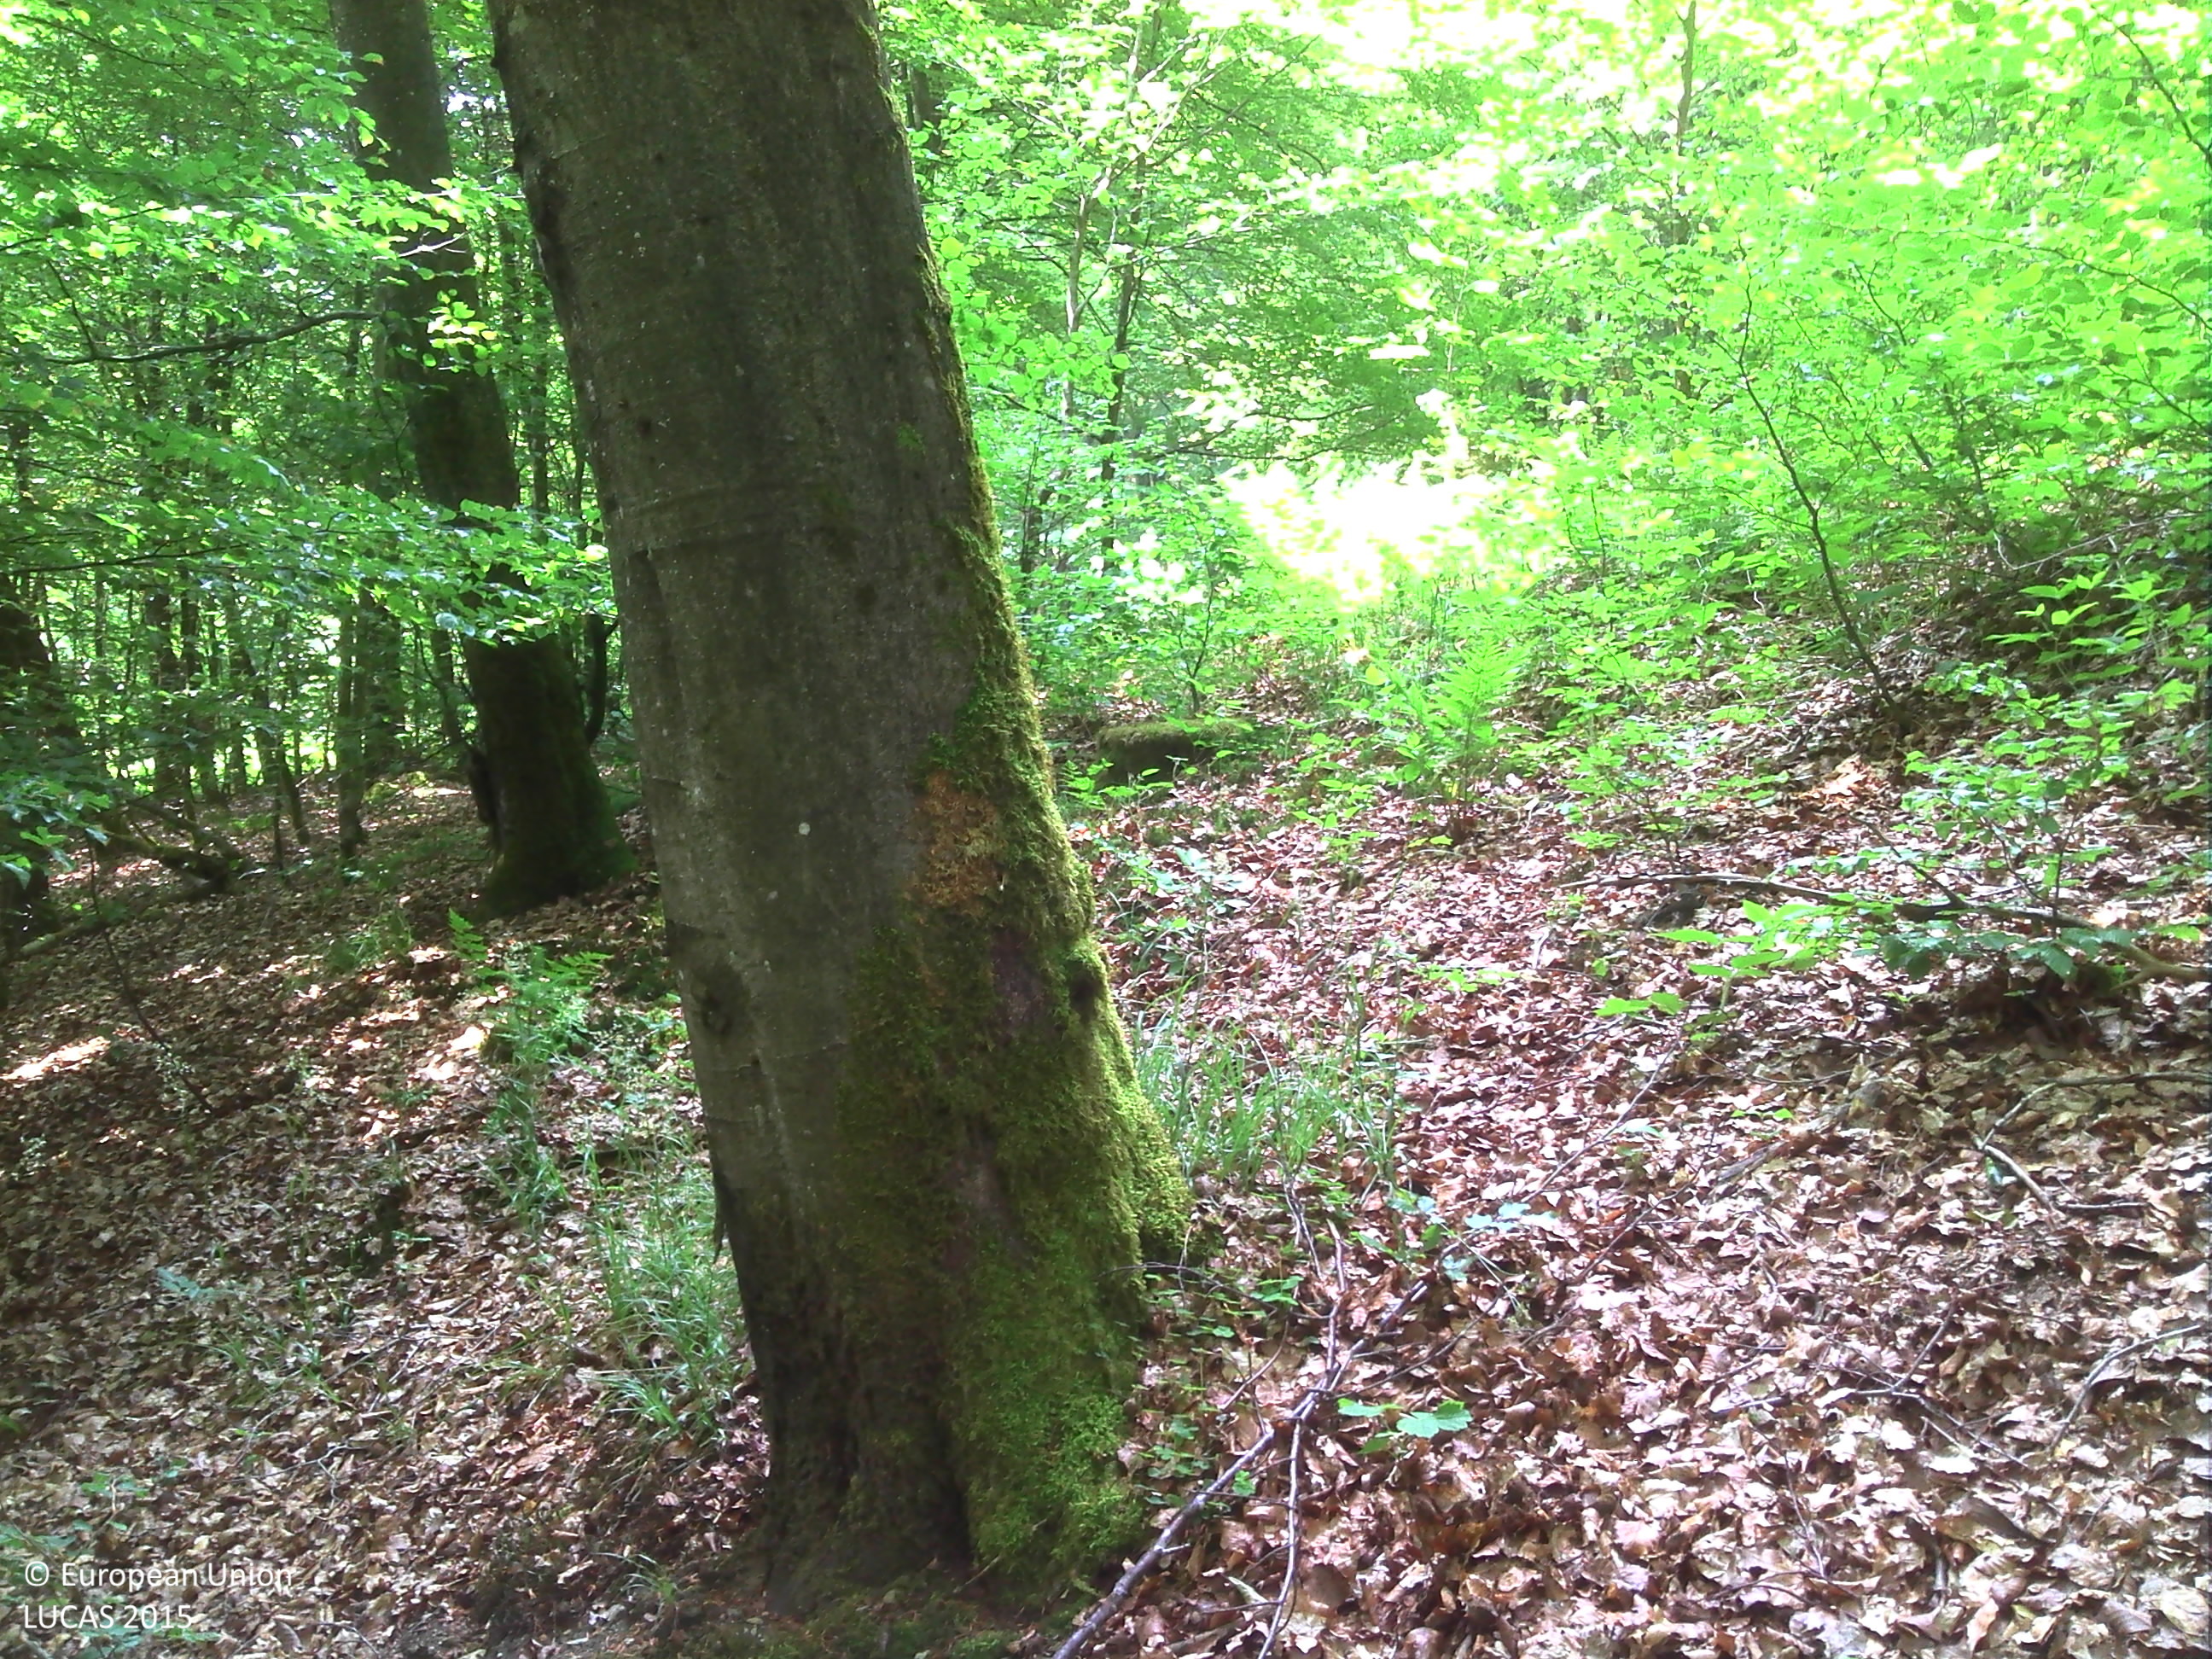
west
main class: Woodland
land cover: Broadleaved woodland
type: beech forest
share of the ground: > 75 %
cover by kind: broadleaved forest trees 100 %
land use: Forestry
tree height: > 5 m
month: June
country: BE
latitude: 50.3924
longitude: 6.2436
